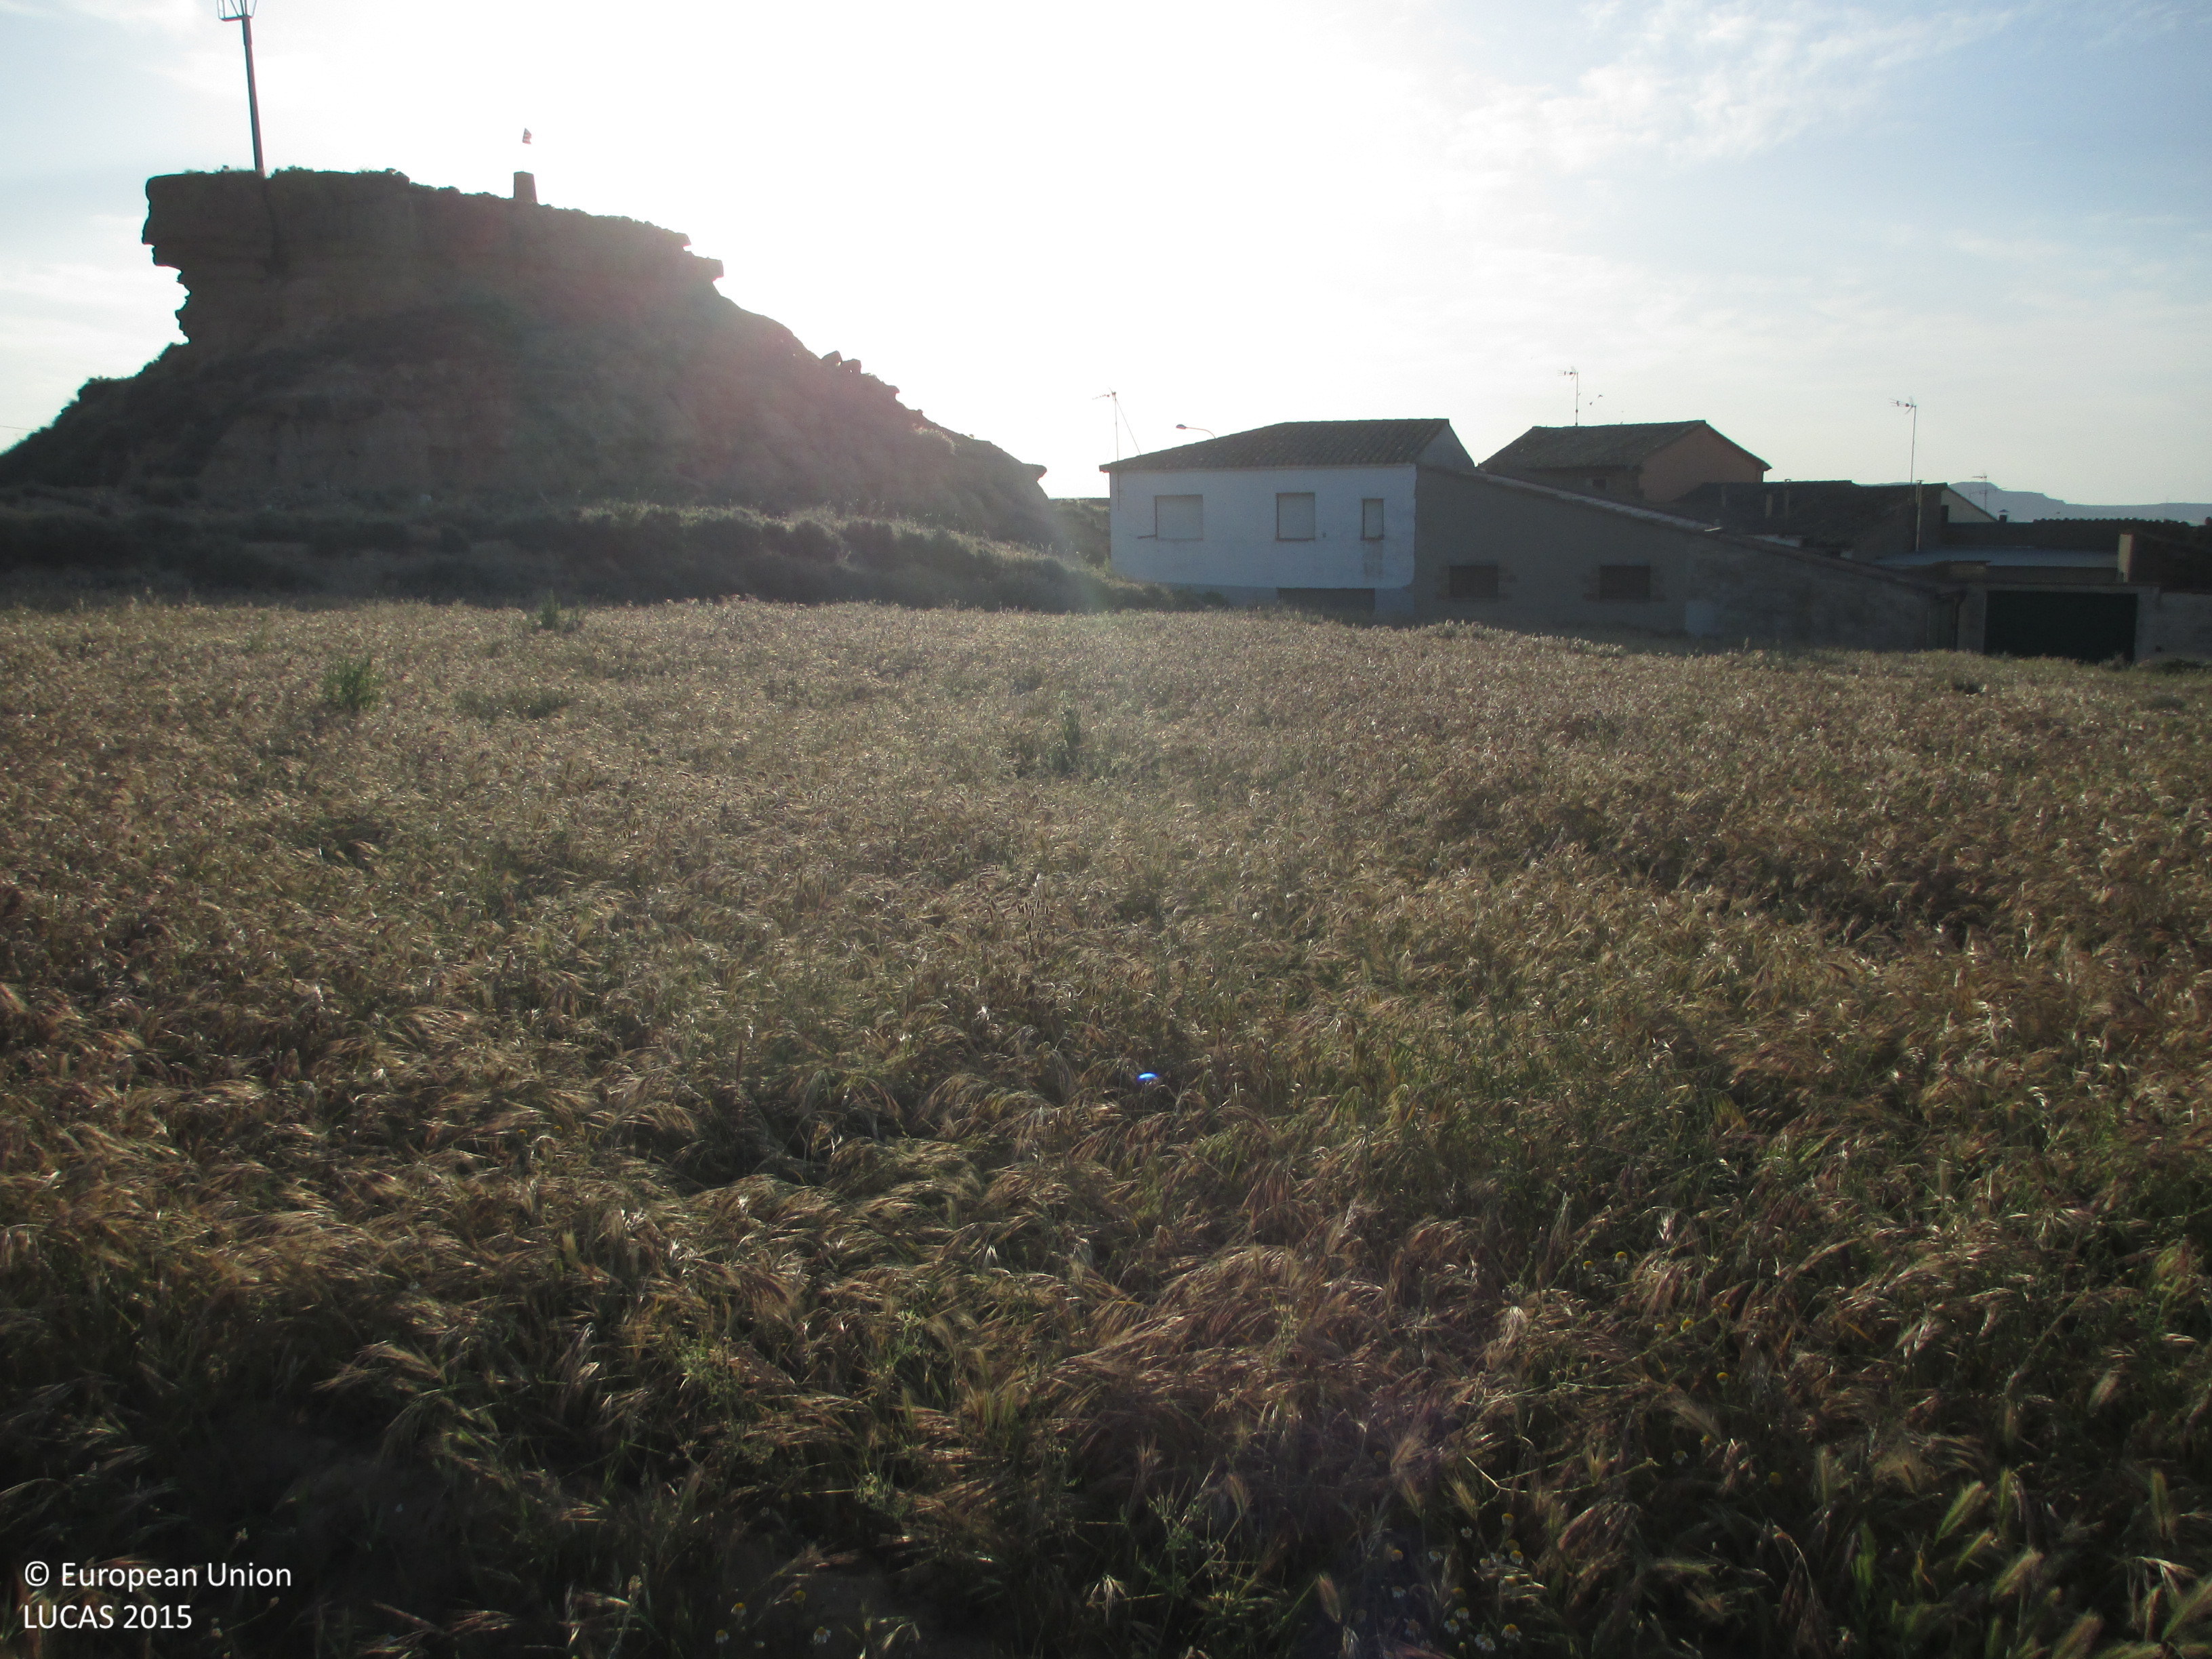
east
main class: Grassland
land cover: Spontaneously vegetated surfaces
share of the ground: > 75 %
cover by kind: herbaceous plants 100 %
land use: Fallow land
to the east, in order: Spontaneously vegetated surfaces; Grass margins; Dry stone walls; Shrubland without tree cover; Artificial constructions in urban areas
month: May
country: ES
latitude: 41.9933
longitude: -0.3664
